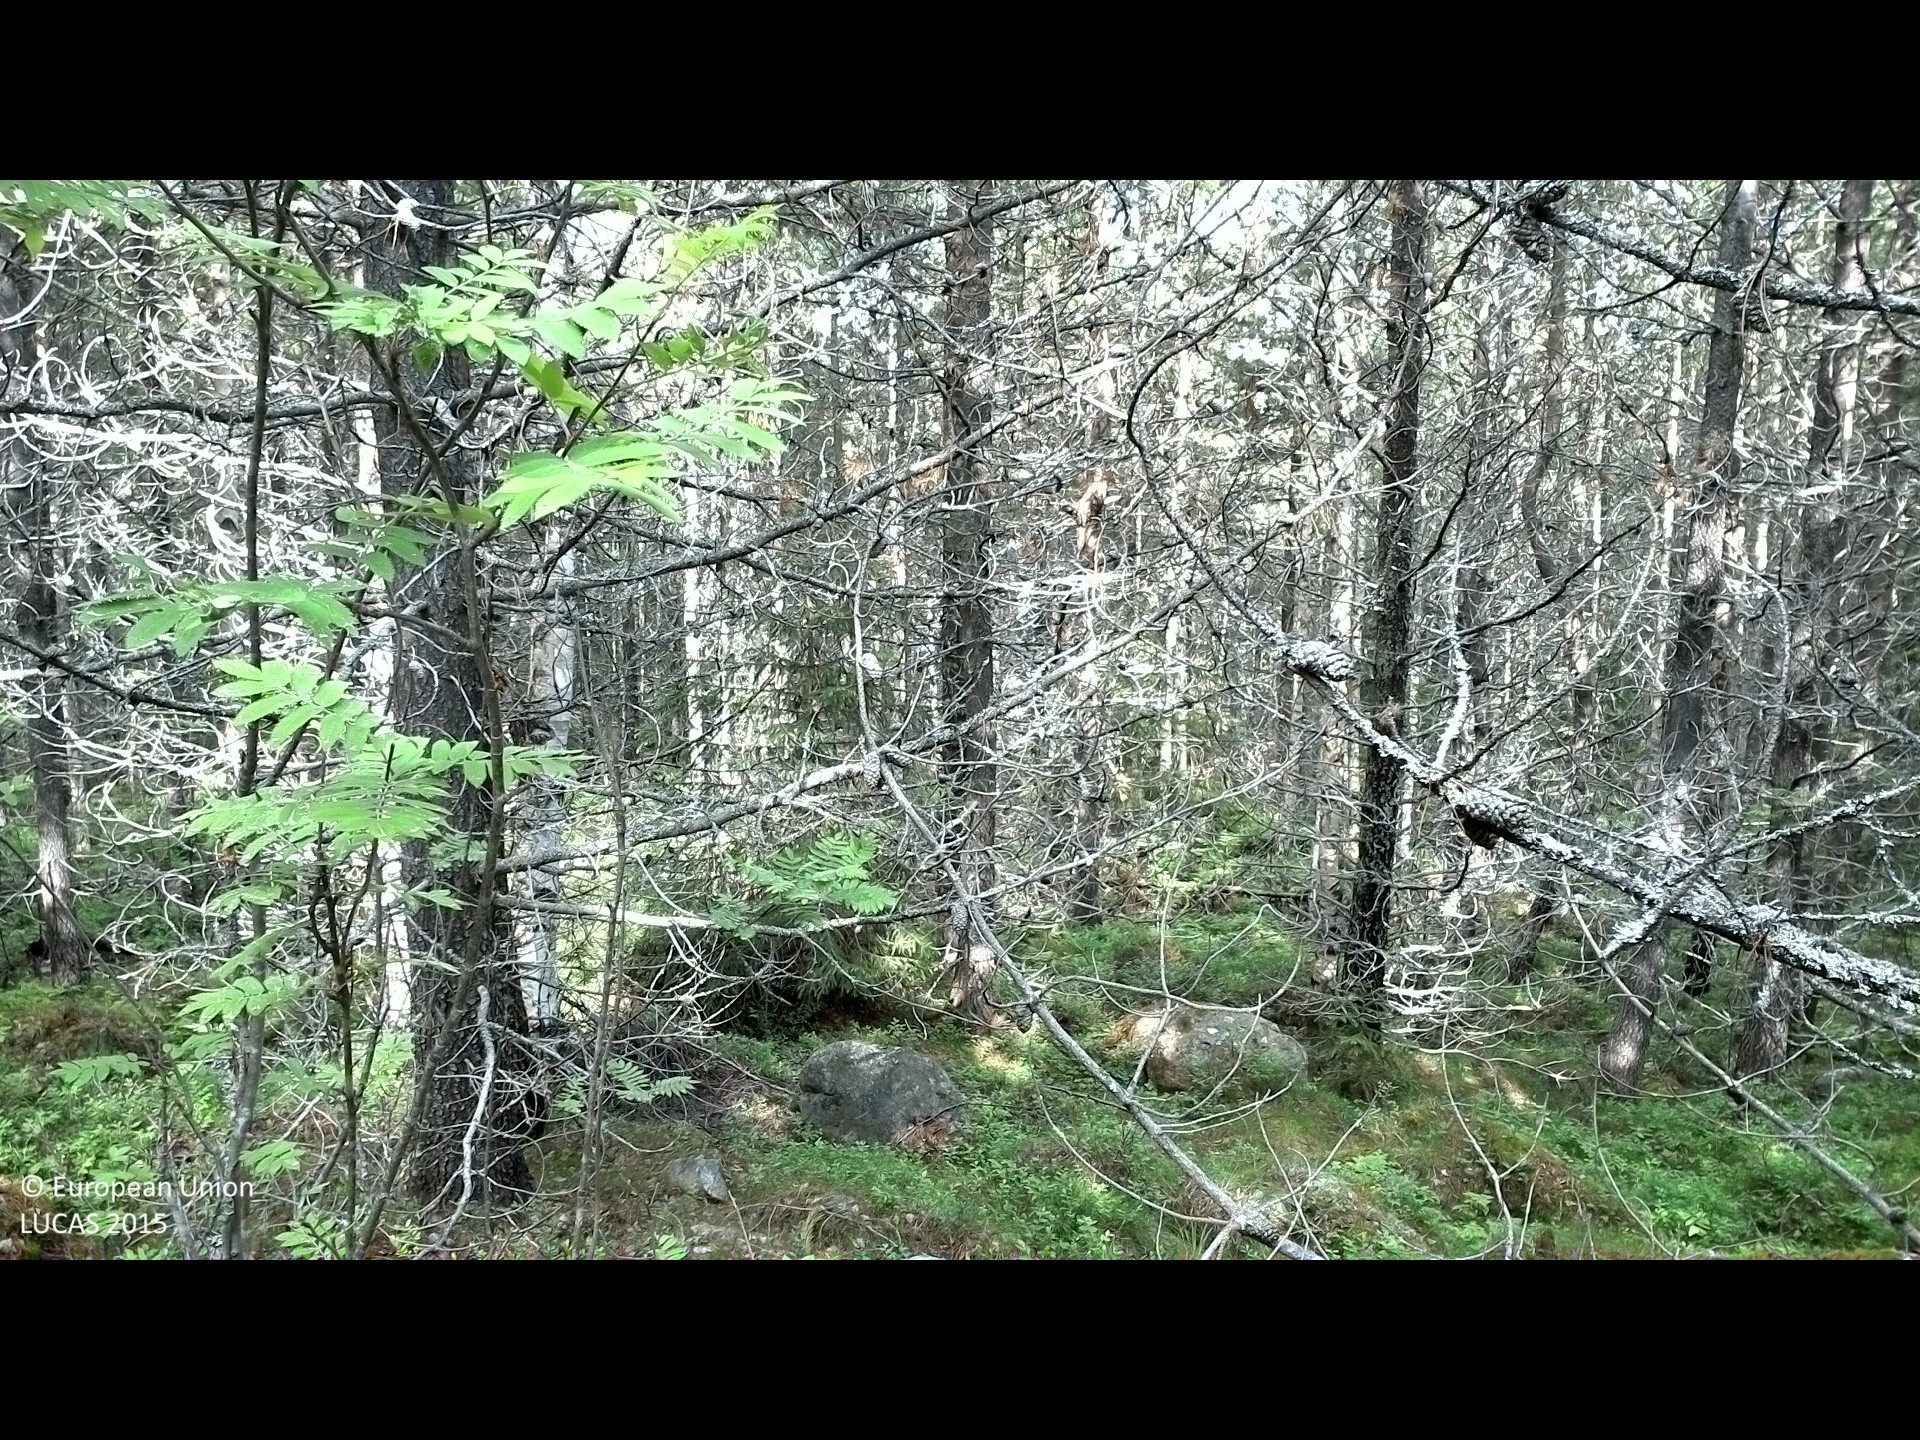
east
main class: Woodland
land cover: Pine dominated coniferous woodland
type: exotic forest
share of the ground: 50 - 75 %
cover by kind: coniferous forest trees 60 %, shrubs 15 %, herbaceous plants 15 %, broadleaved forest trees 5 %, lichens and mosses 5 %
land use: Forestry
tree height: > 5 m
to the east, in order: Pine dominated coniferous woodland; Pine dominated mixed woodland; Pine dominated coniferous woodland; Spruce dominated mixed woodland; Other mixed woodland; Rivers and streams; Other mixed woodland; Spruce dominated mixed woodland
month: June
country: SE
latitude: 62.0438
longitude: 16.7697
